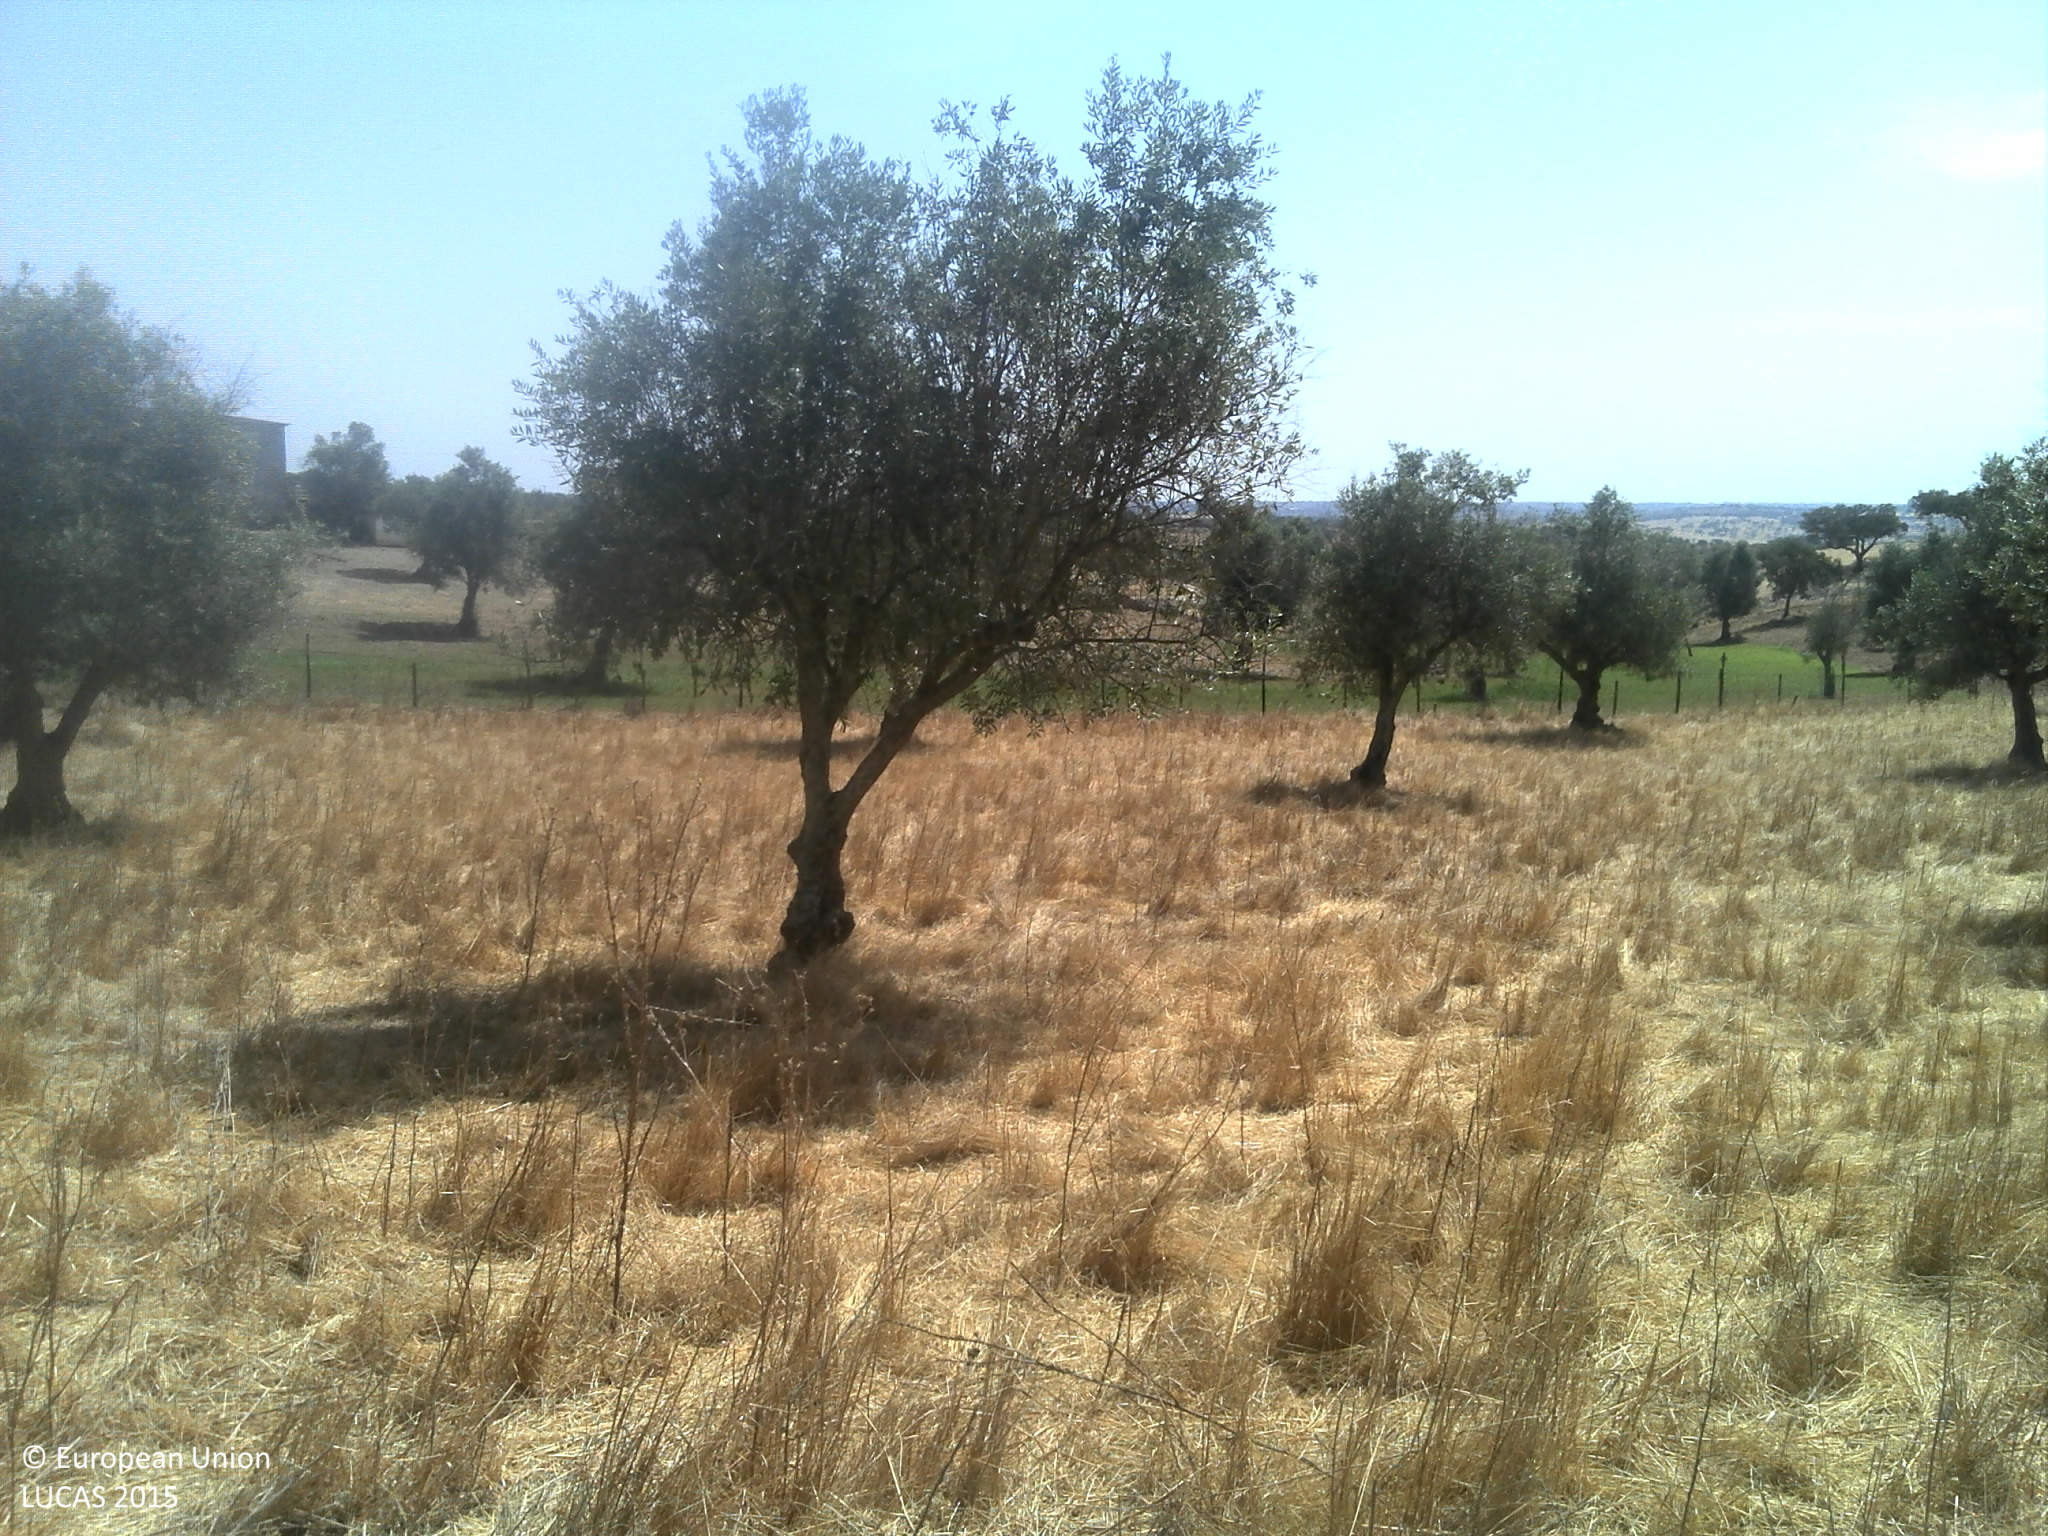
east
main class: Cropland
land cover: Olive groves
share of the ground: 25 - 50 %
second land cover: Grassland without tree/shrub cover
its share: 50 - 75 %
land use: Agriculture (excluding fallow land and kitchen gardens)
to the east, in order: Olive groves; Grassland without tree/shrub cover; Fences; Other cereals; Olive groves; Fences; Grass margins; Tracks; Grass margins; Other bare soil
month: August
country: PT
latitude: 37.5950
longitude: -8.2517
